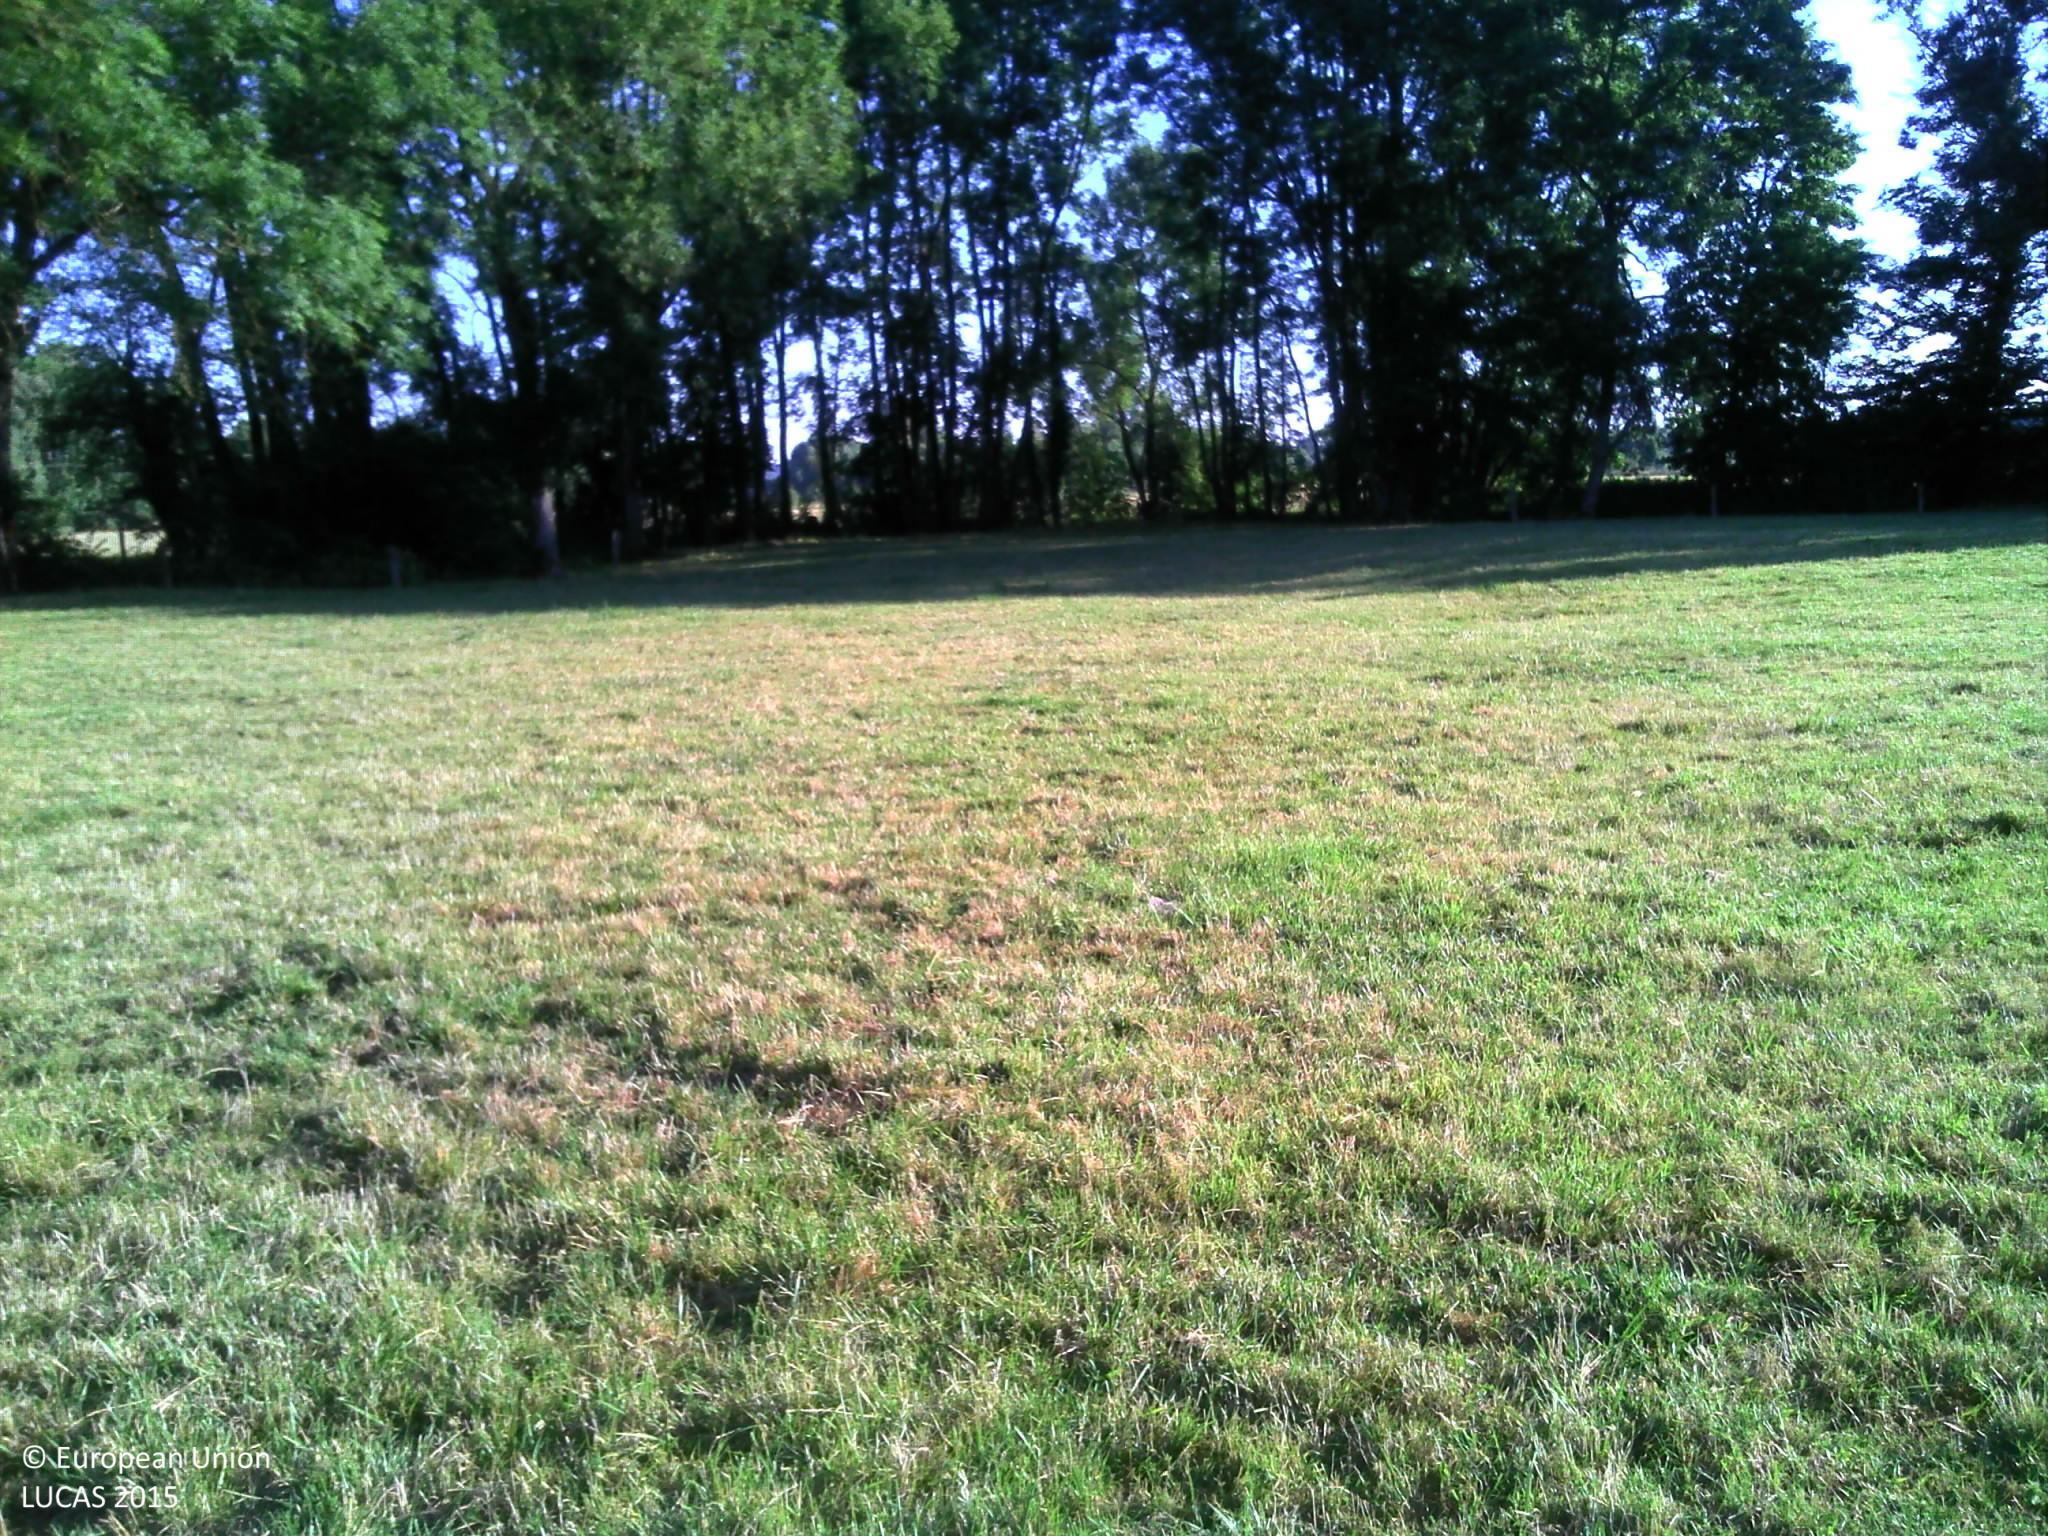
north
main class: Grassland
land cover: Grassland without tree/shrub cover
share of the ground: > 75 %
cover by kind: herbaceous plants 100 %
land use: Agriculture (excluding fallow land and kitchen gardens)
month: July
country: FR
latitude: 48.8837
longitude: 4.9658
